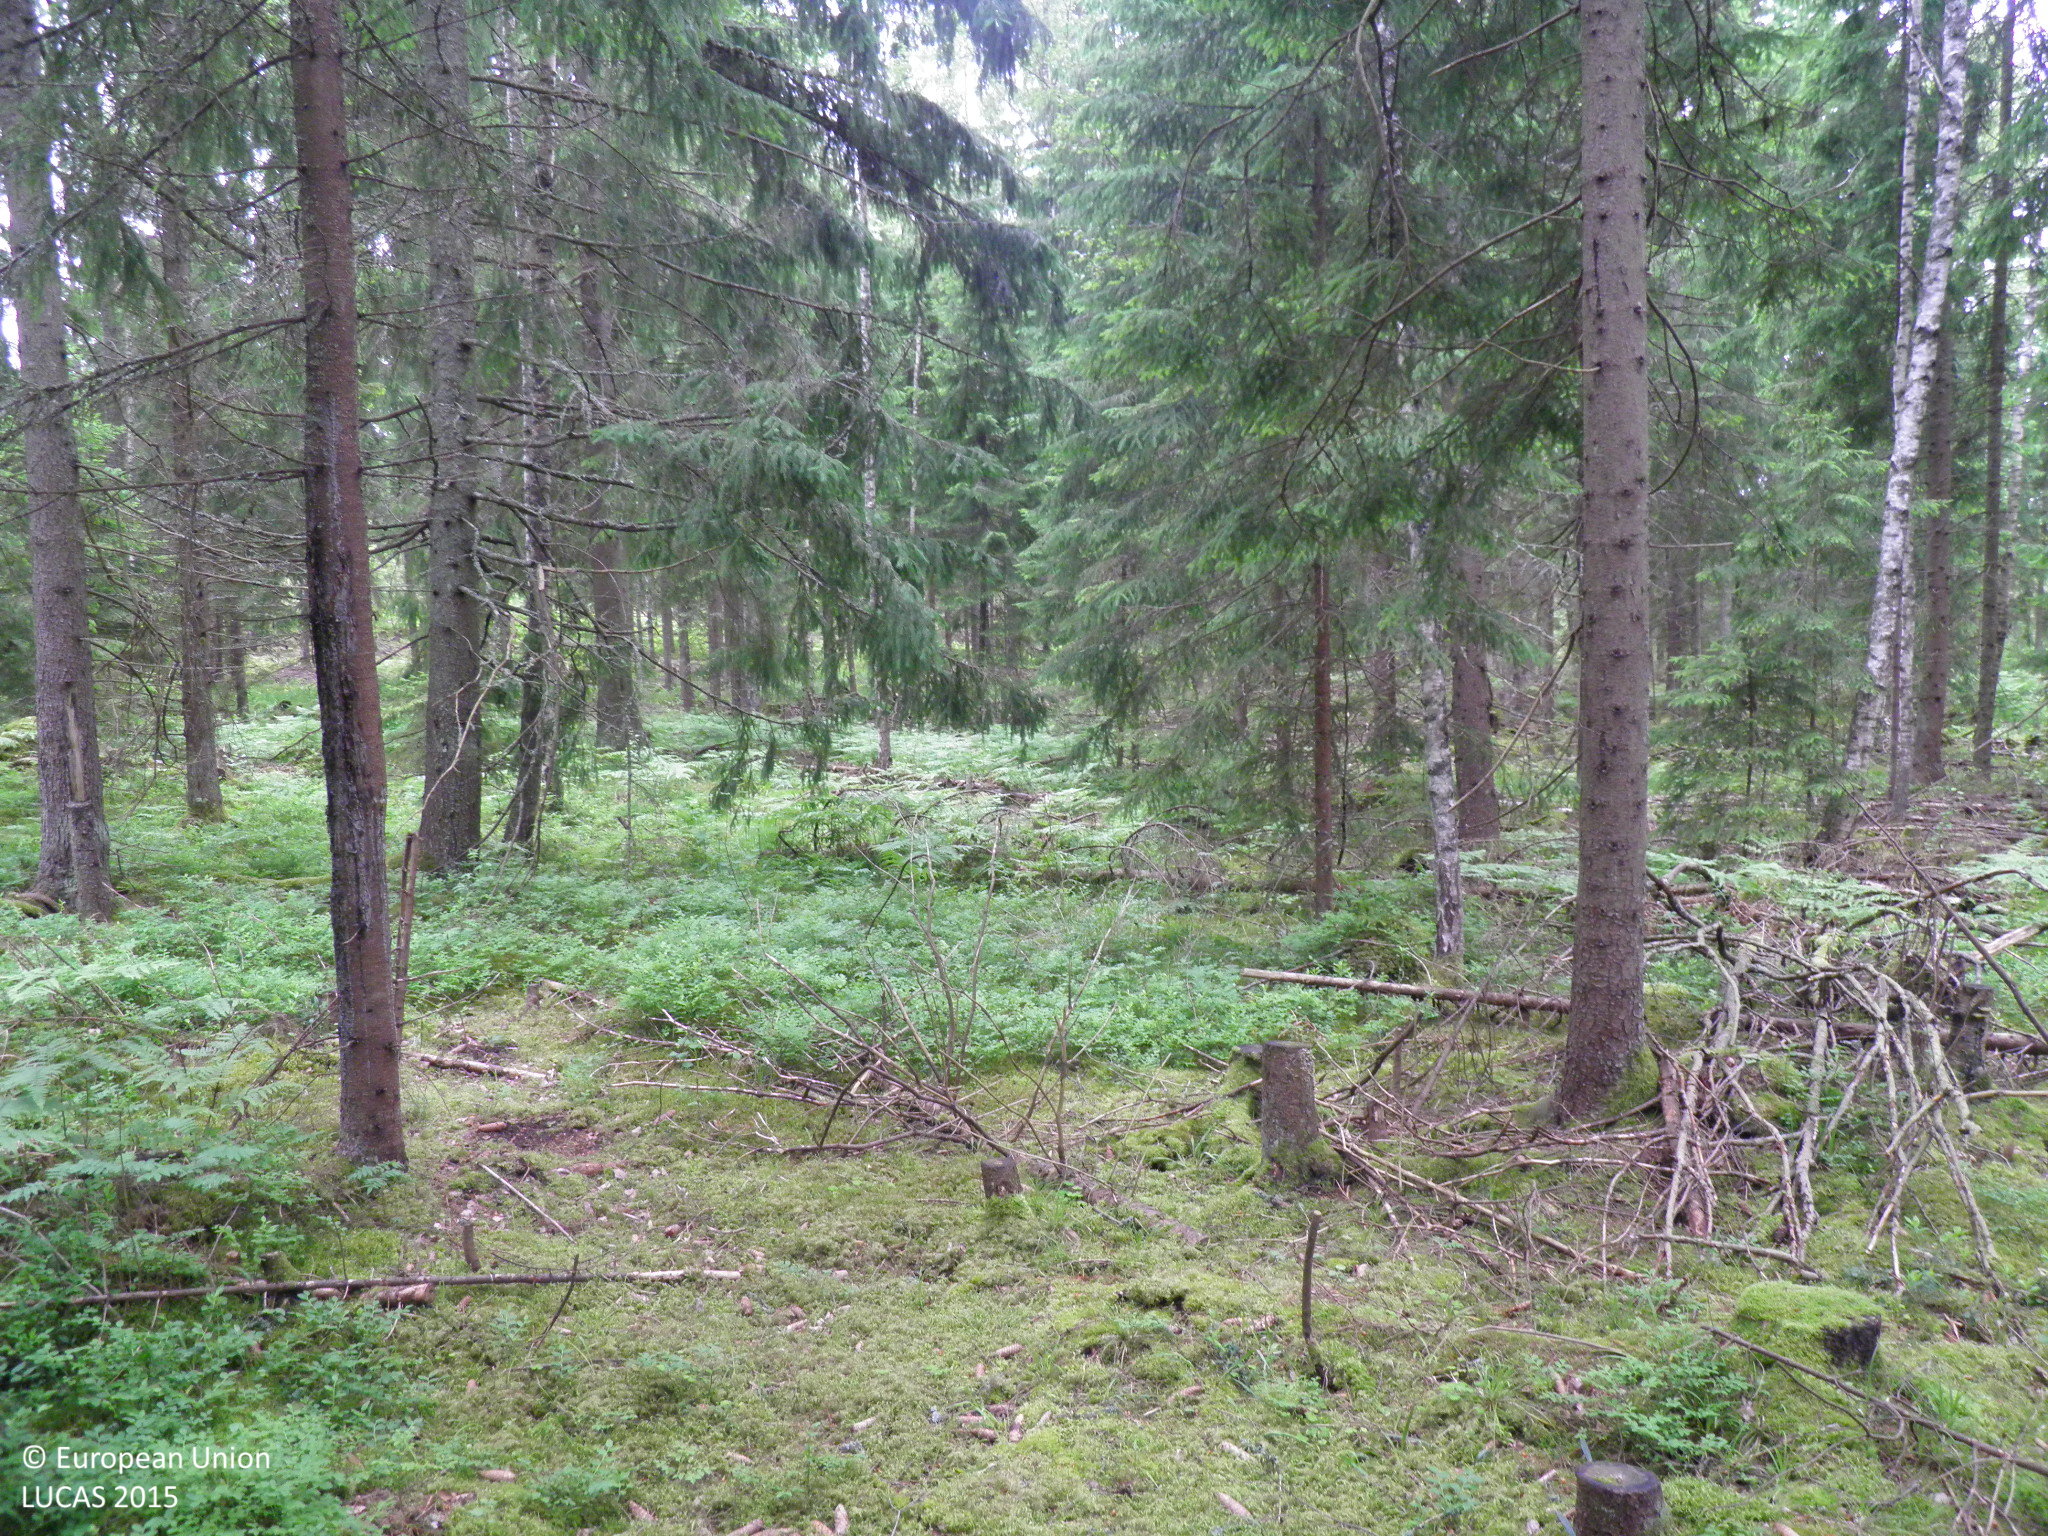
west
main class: Woodland
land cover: Spruce dominated coniferous woodland
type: hemiboreal forest and nemoral coniferous forest and mixed broadleaved-coniferous forest
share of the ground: > 75 %
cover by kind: coniferous forest trees 70 %, broadleaved forest trees 10 %, herbaceous plants 10 %, shrubs 5 %, lichens and mosses 5 %
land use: Forestry
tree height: > 5 m
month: June
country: FI
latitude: 60.2725
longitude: 22.1616
